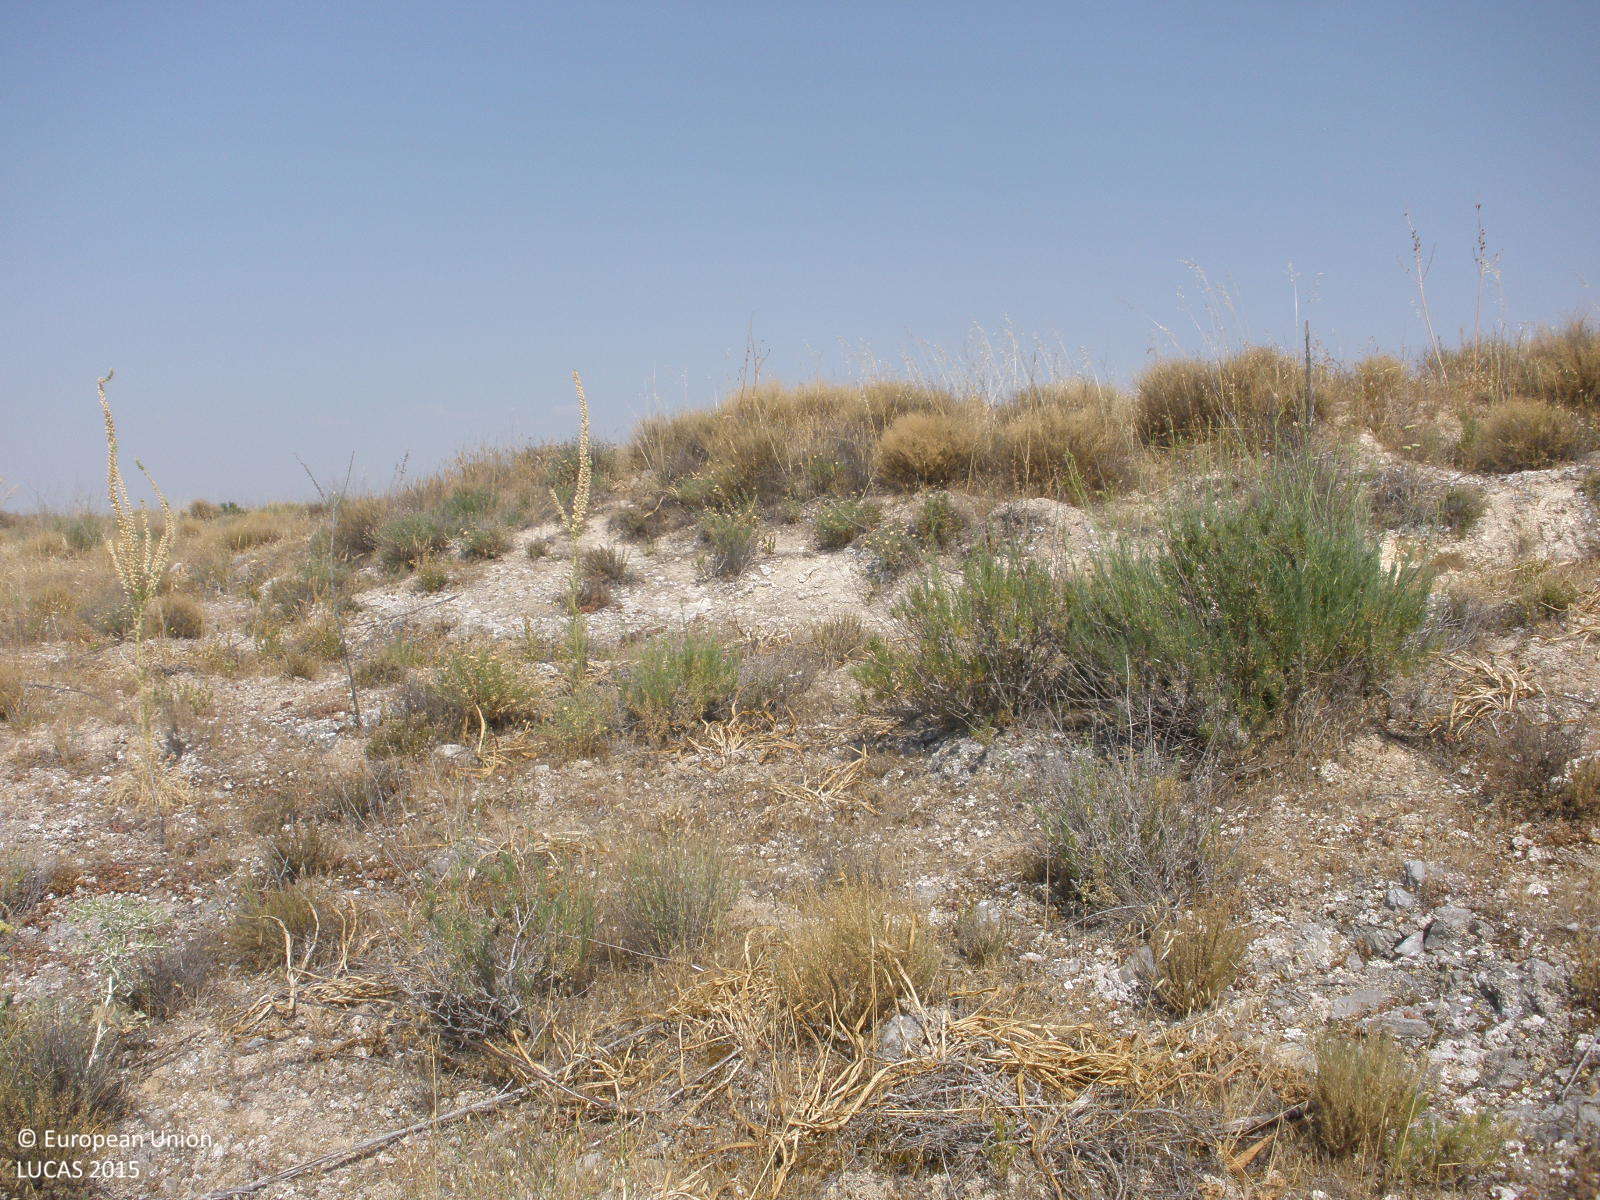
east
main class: Shrubland
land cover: Shrubland without tree cover
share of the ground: 25 - 50 %
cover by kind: herbaceous plants 50 %, shrubs 30 %, consolidated bare surface 20 %
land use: Semi-natural and natural areas not in use
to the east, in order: Shrubland without tree cover; Pine dominated coniferous woodland
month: July
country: ES
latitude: 40.0278
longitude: -3.3514
